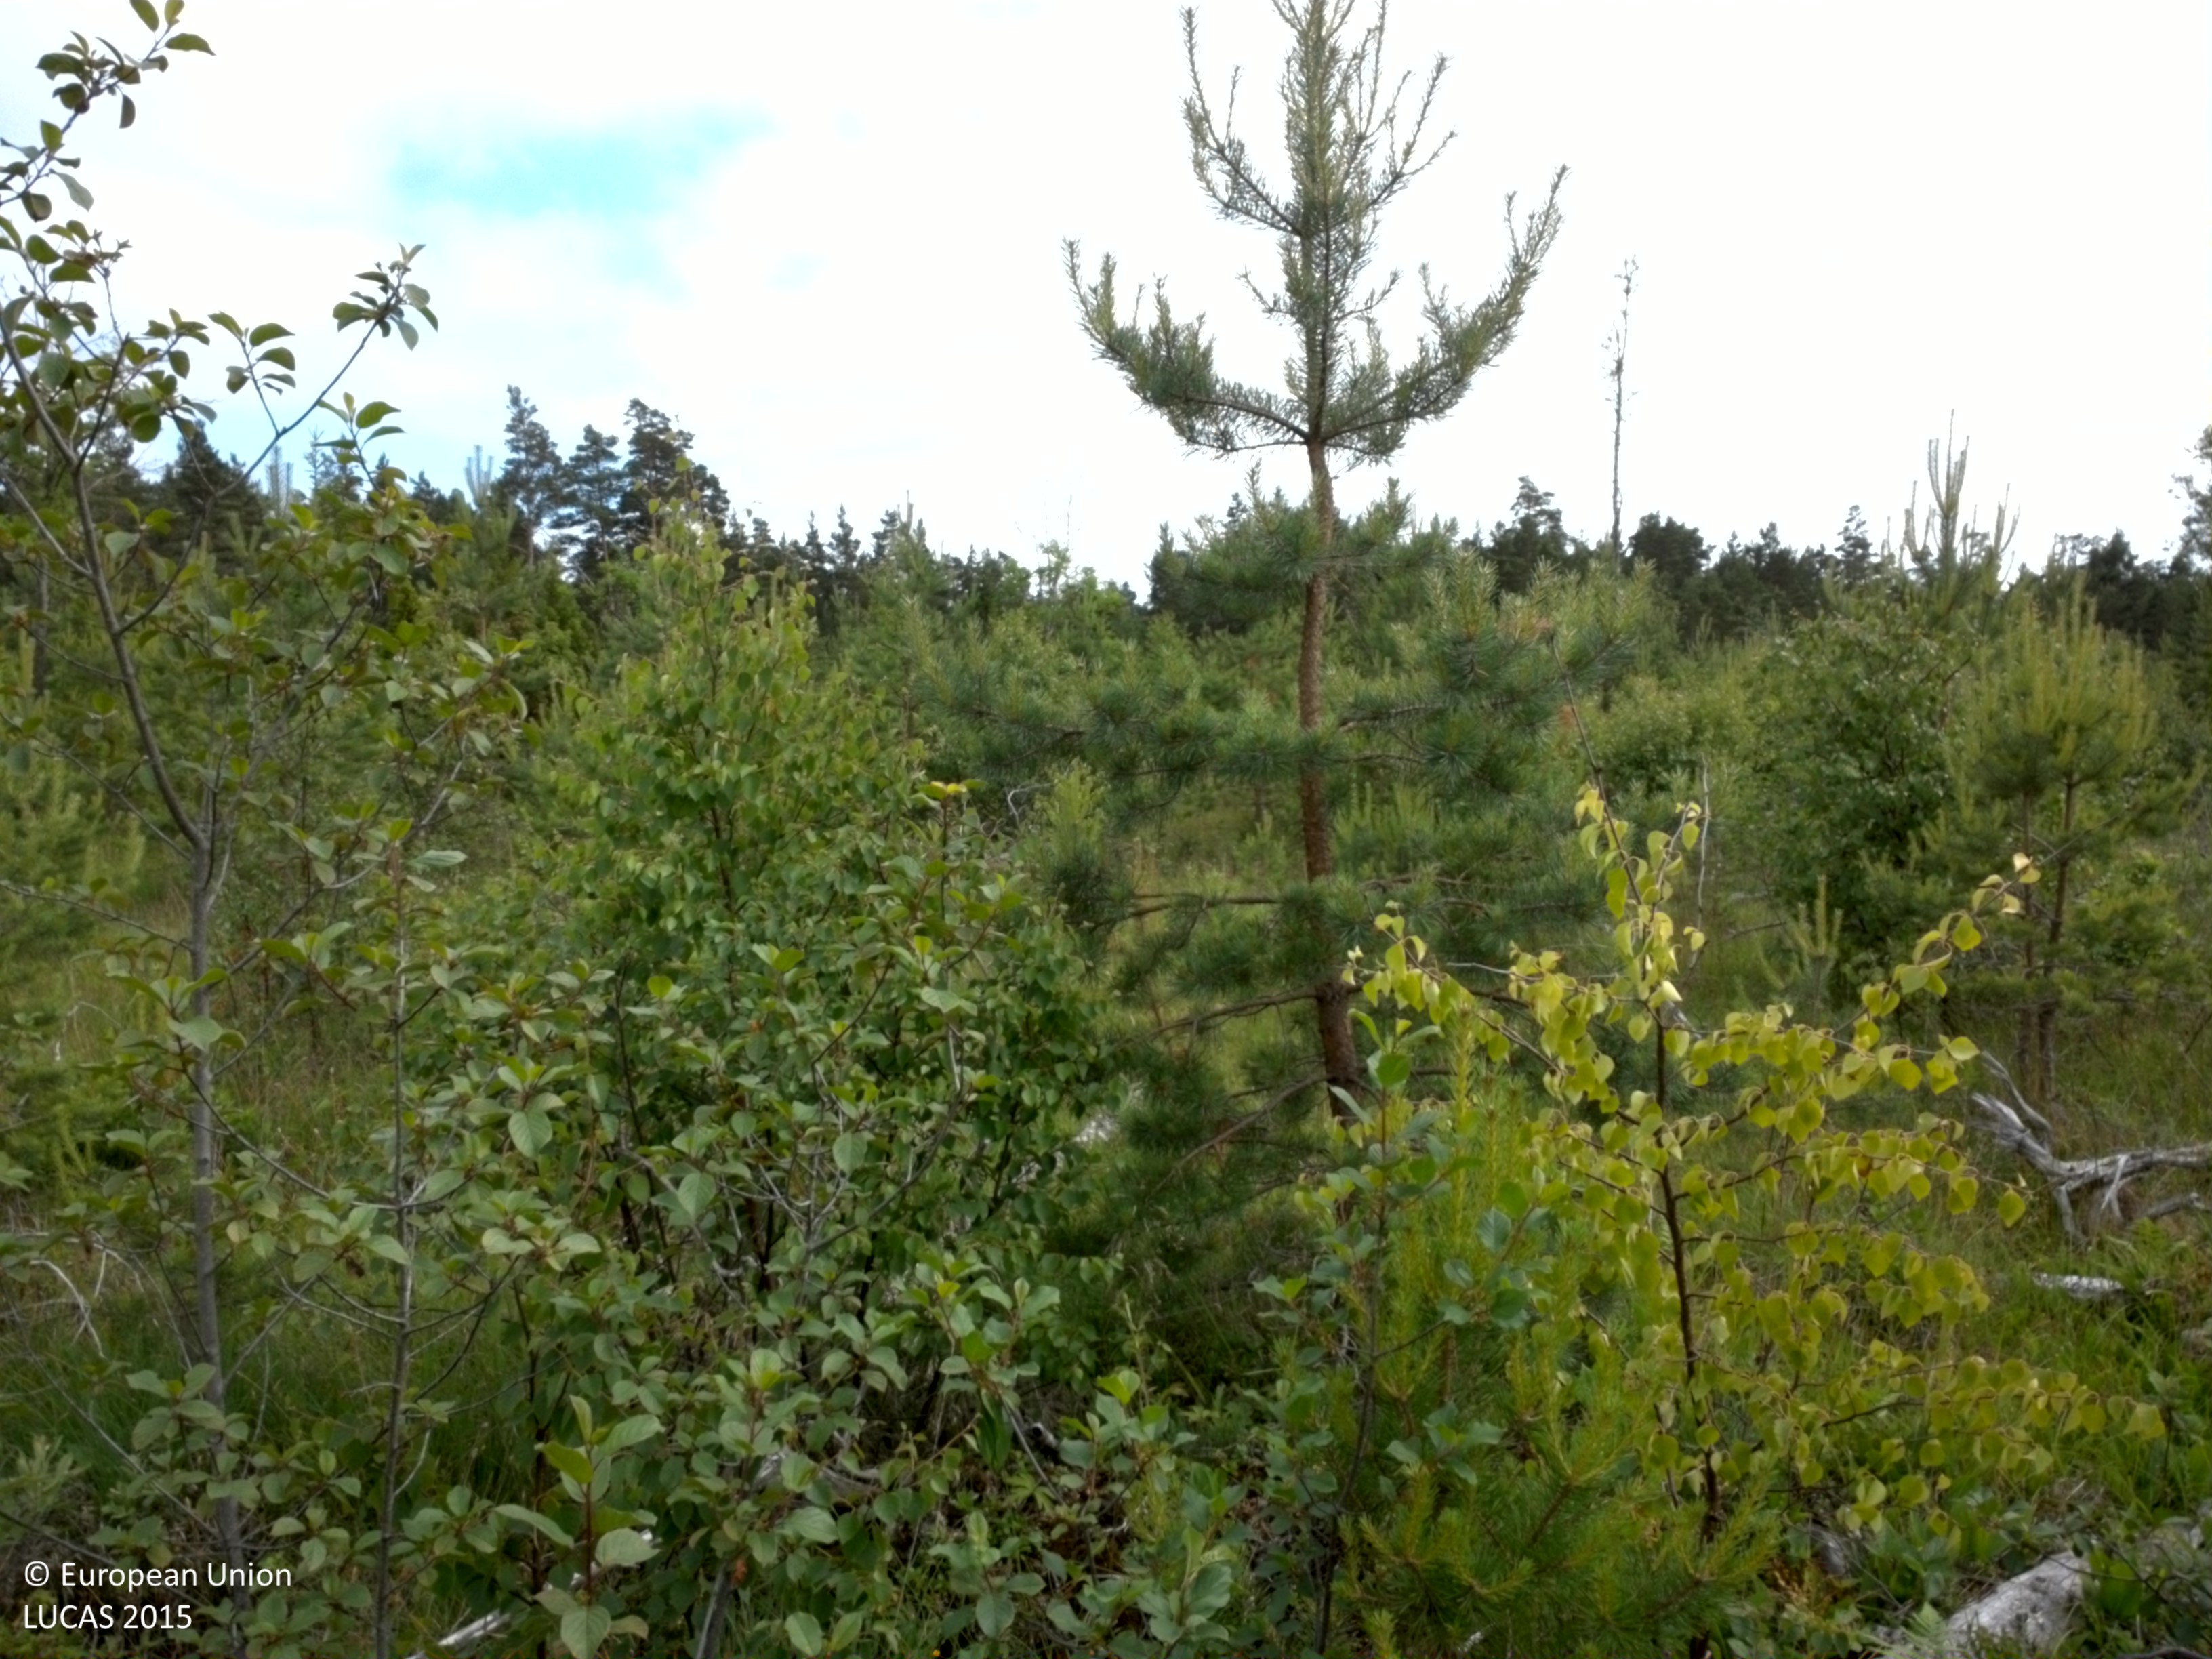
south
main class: Woodland
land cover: Pine dominated mixed woodland
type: hemiboreal forest and nemoral coniferous forest and mixed broadleaved-coniferous forest
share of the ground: 50 - 75 %
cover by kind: coniferous forest trees 45 %, herbaceous plants 30 %, broadleaved forest trees 25 %
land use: Forestry
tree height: < 5 m
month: June
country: SE
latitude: 57.8788
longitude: 18.7605
